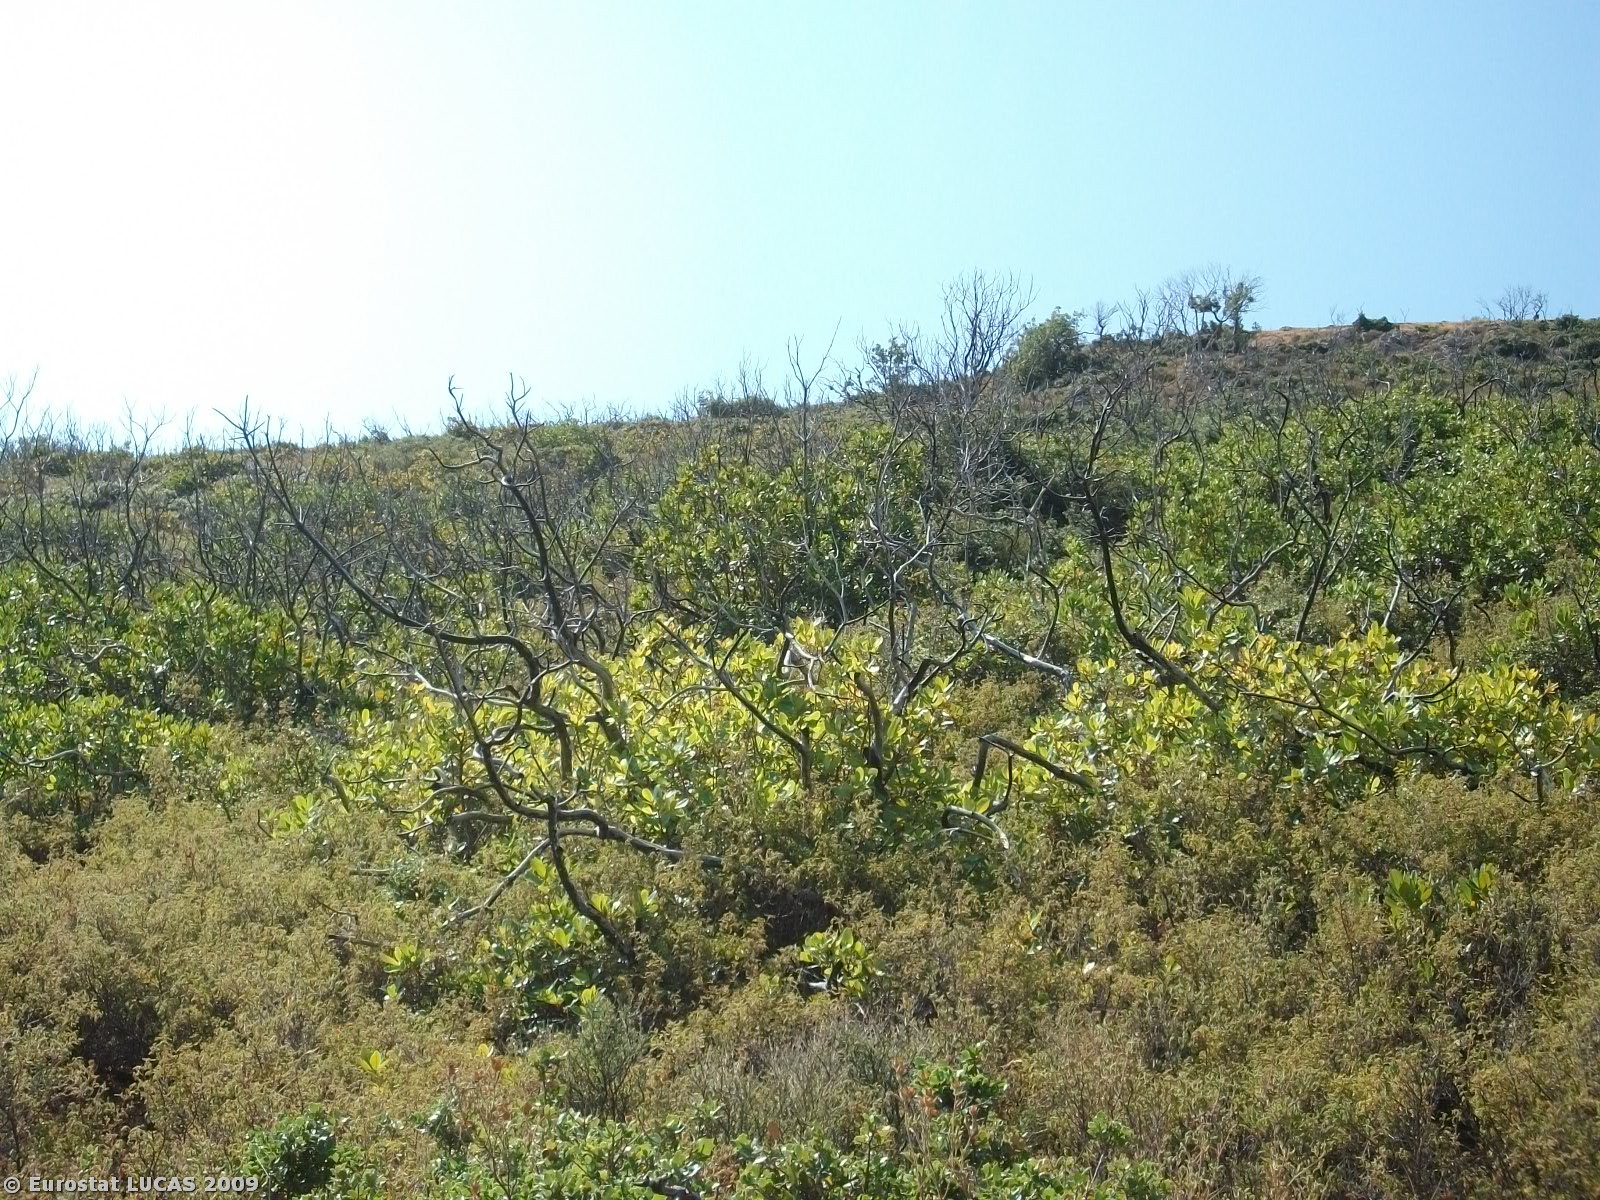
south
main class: Shrubland
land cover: Shrubland without tree cover
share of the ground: > 75 %
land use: Unused
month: August
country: GR
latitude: 38.6143
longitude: 23.1100
